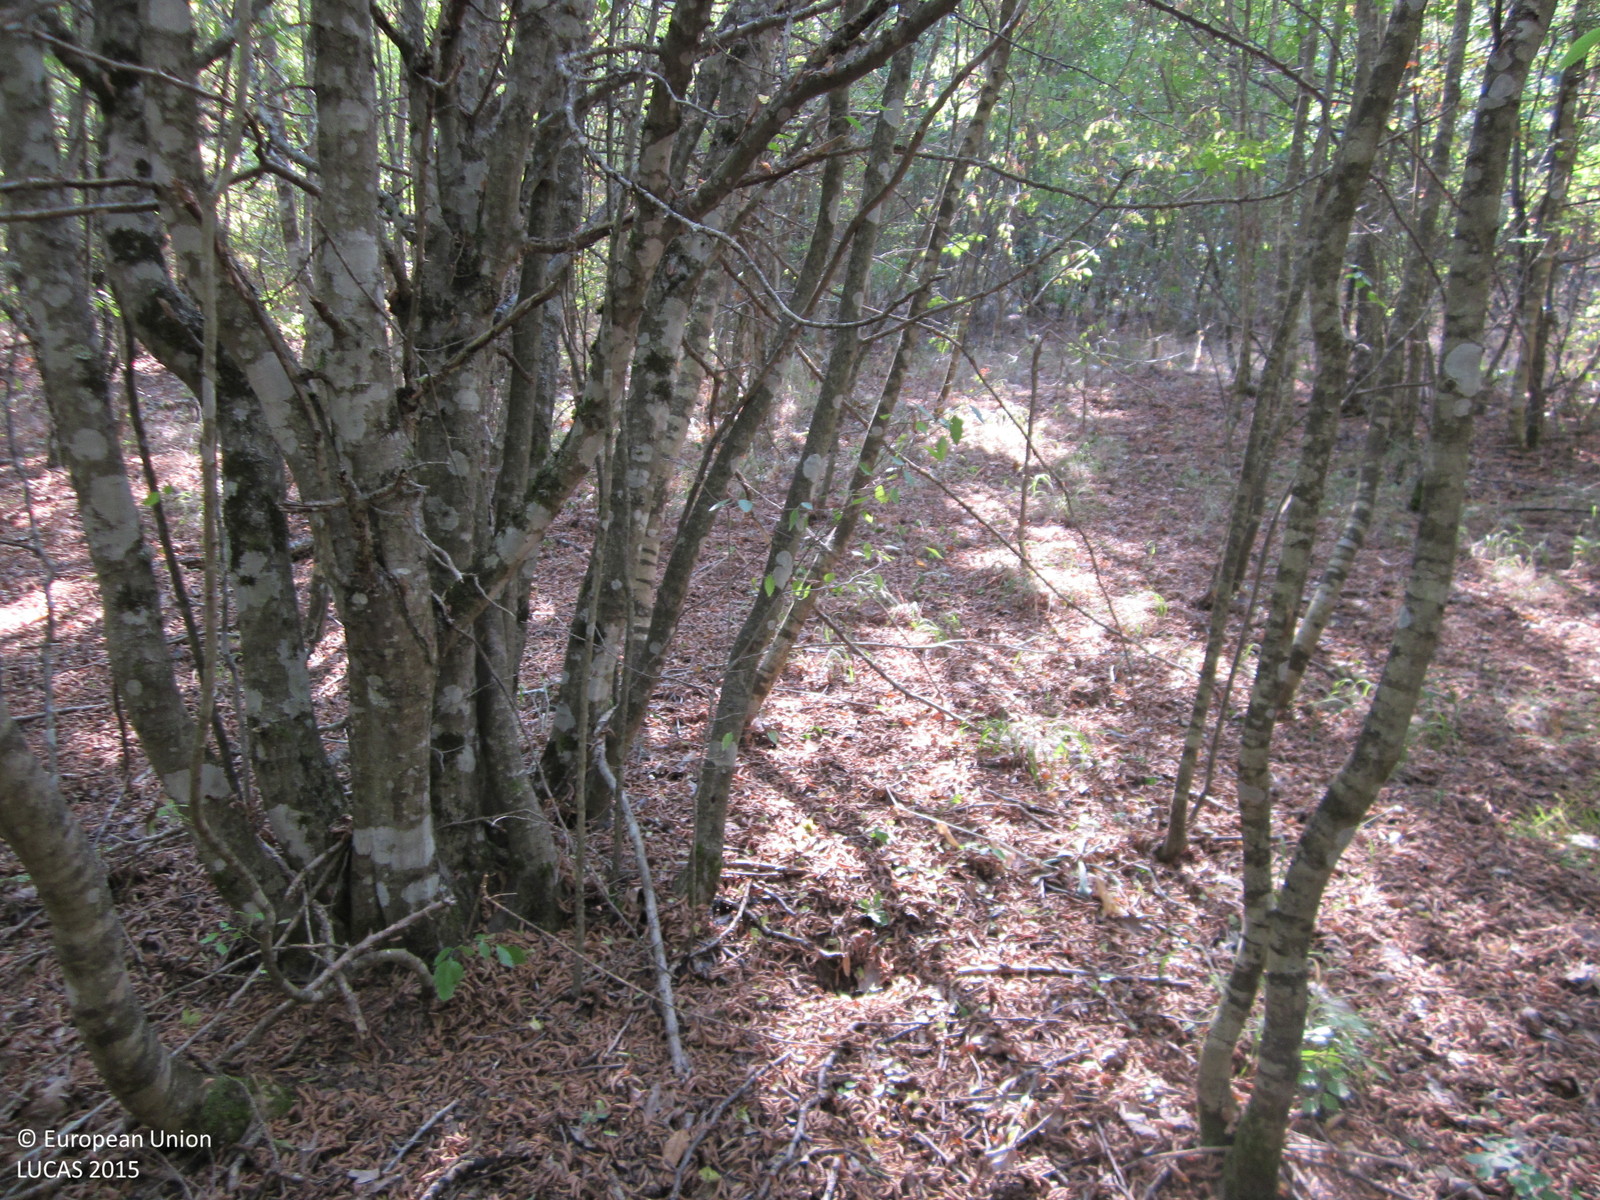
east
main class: Woodland
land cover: Broadleaved woodland
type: thermophilous deciduous forest
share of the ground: > 75 %
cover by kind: broadleaved forest trees 95 %, unconsolidated bare surface 5 %
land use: Forestry
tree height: > 5 m
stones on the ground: < 10 %
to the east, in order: Broadleaved woodland
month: August
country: BG
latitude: 42.0358
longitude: 27.6177
